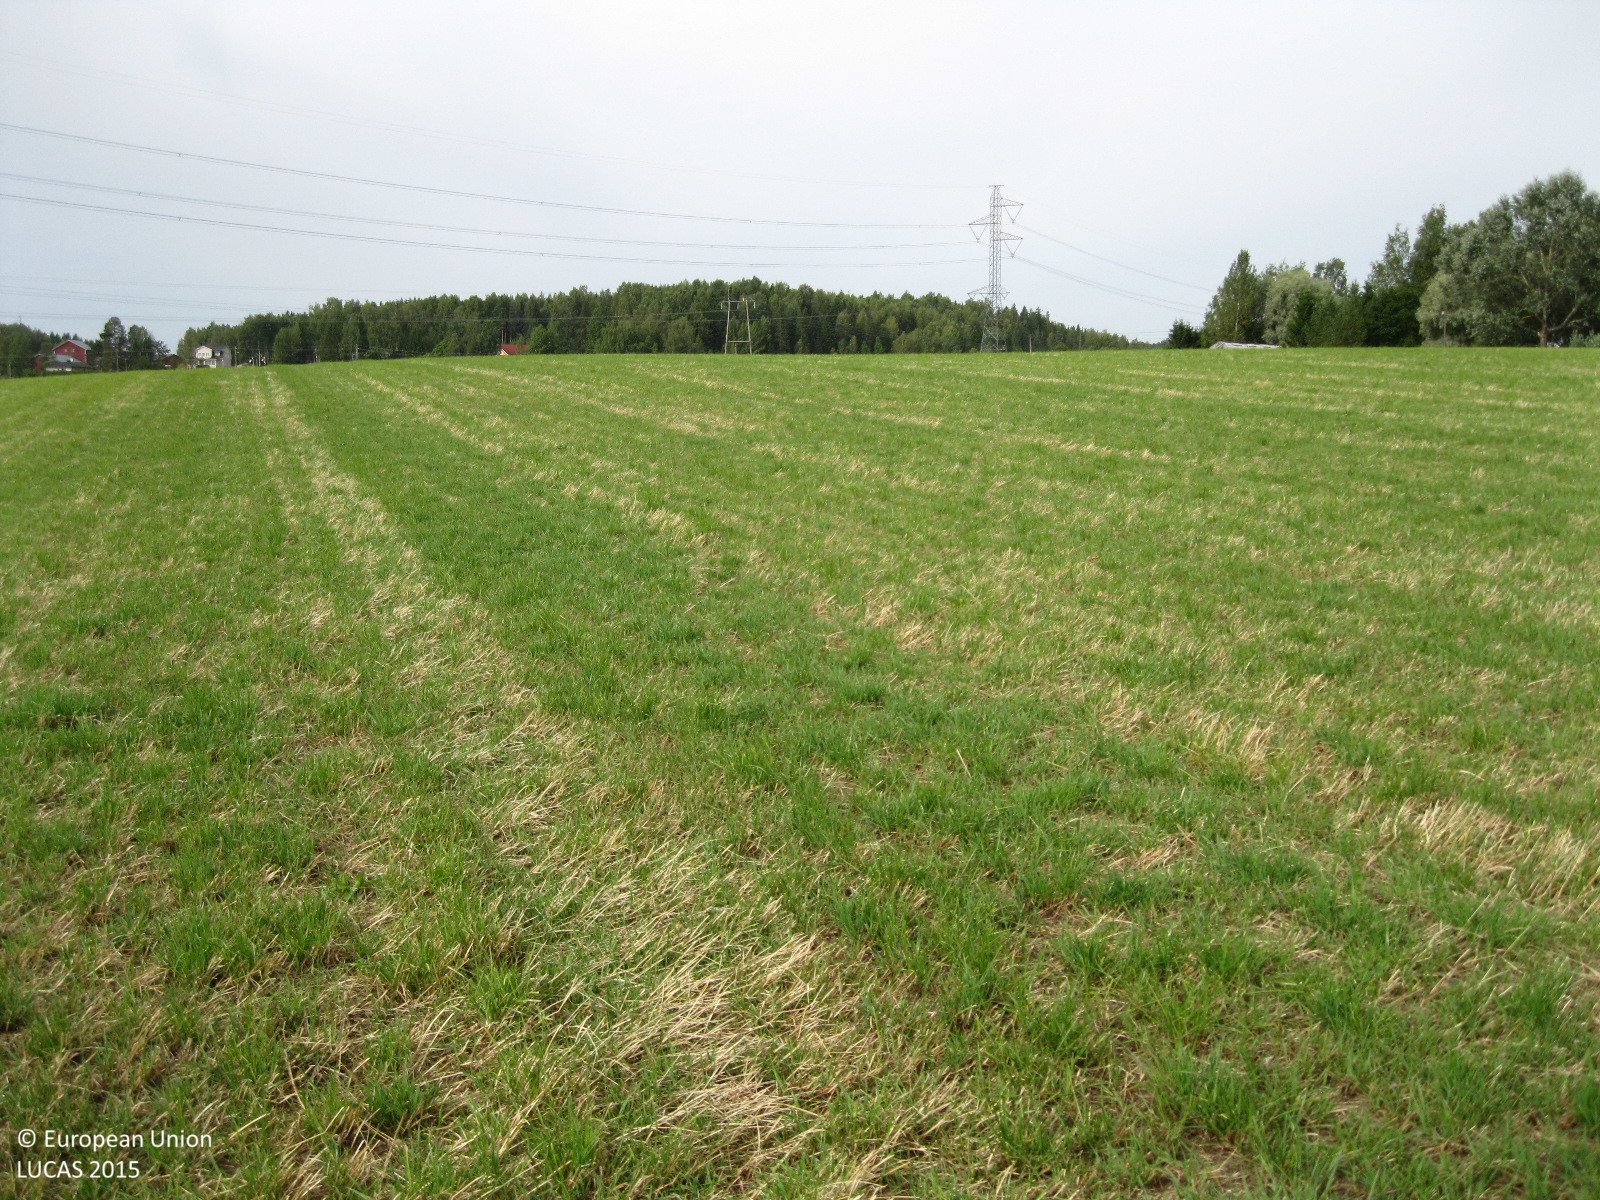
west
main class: Cropland
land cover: Temporary grasslands
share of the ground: > 75 %
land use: Agriculture (excluding fallow land and kitchen gardens)
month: September
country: FI
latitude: 60.3790
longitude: 24.8613
